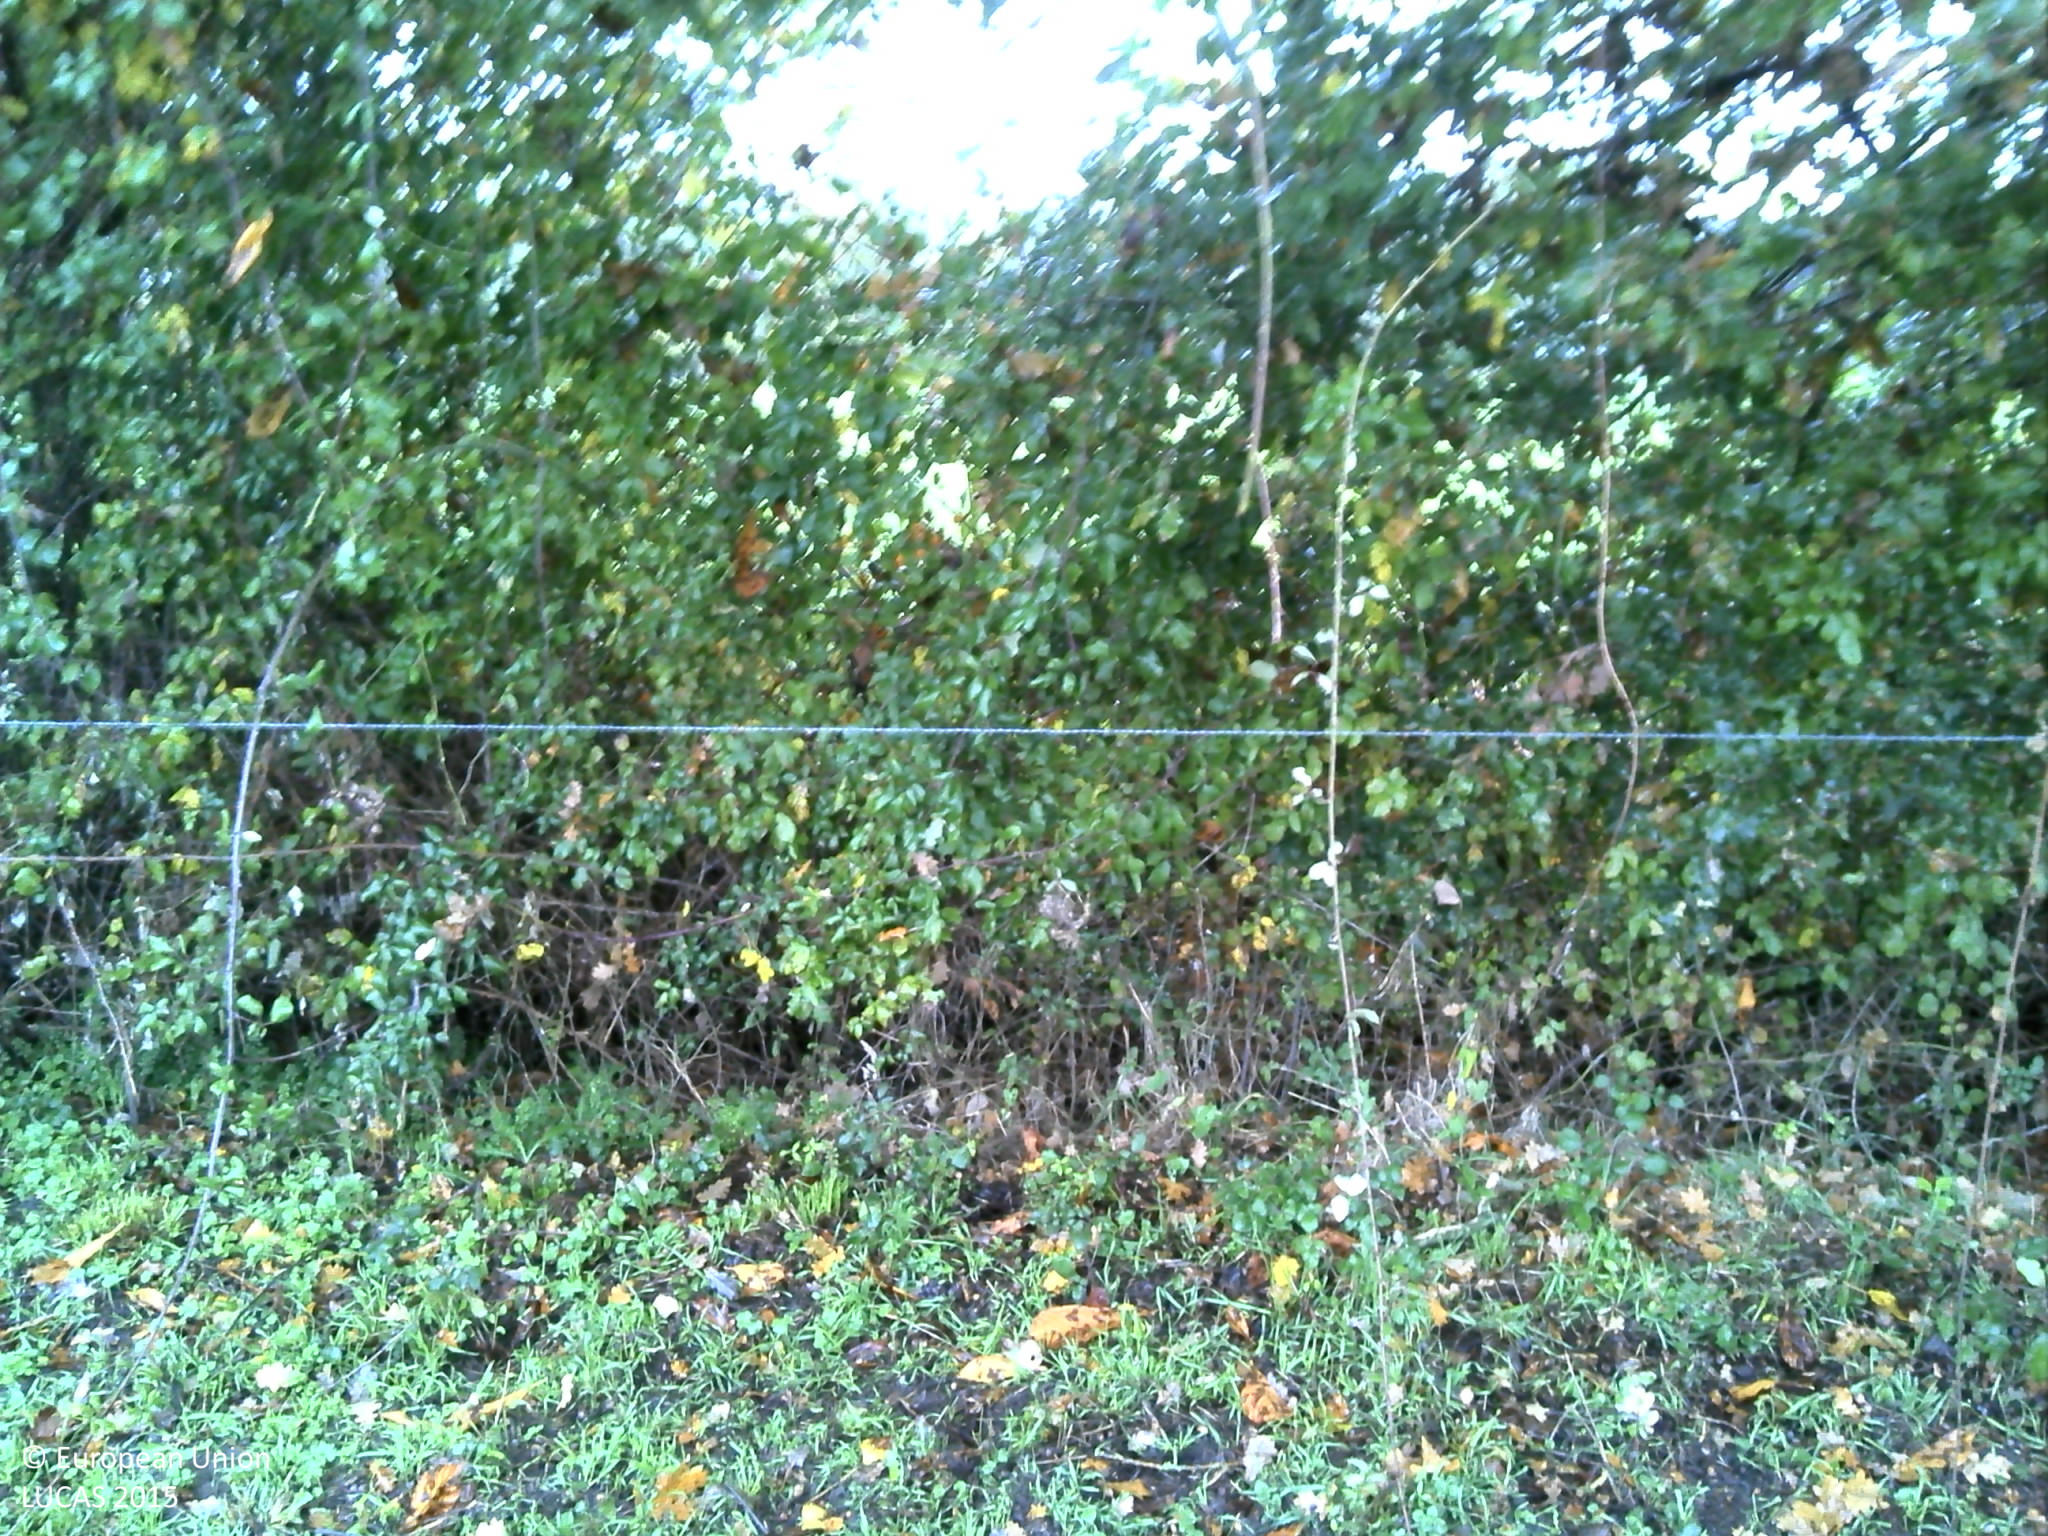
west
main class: Cropland
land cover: Temporary grasslands
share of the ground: > 75 %
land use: Agriculture (excluding fallow land and kitchen gardens)
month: November
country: FR
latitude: 47.6168
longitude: -1.5256
